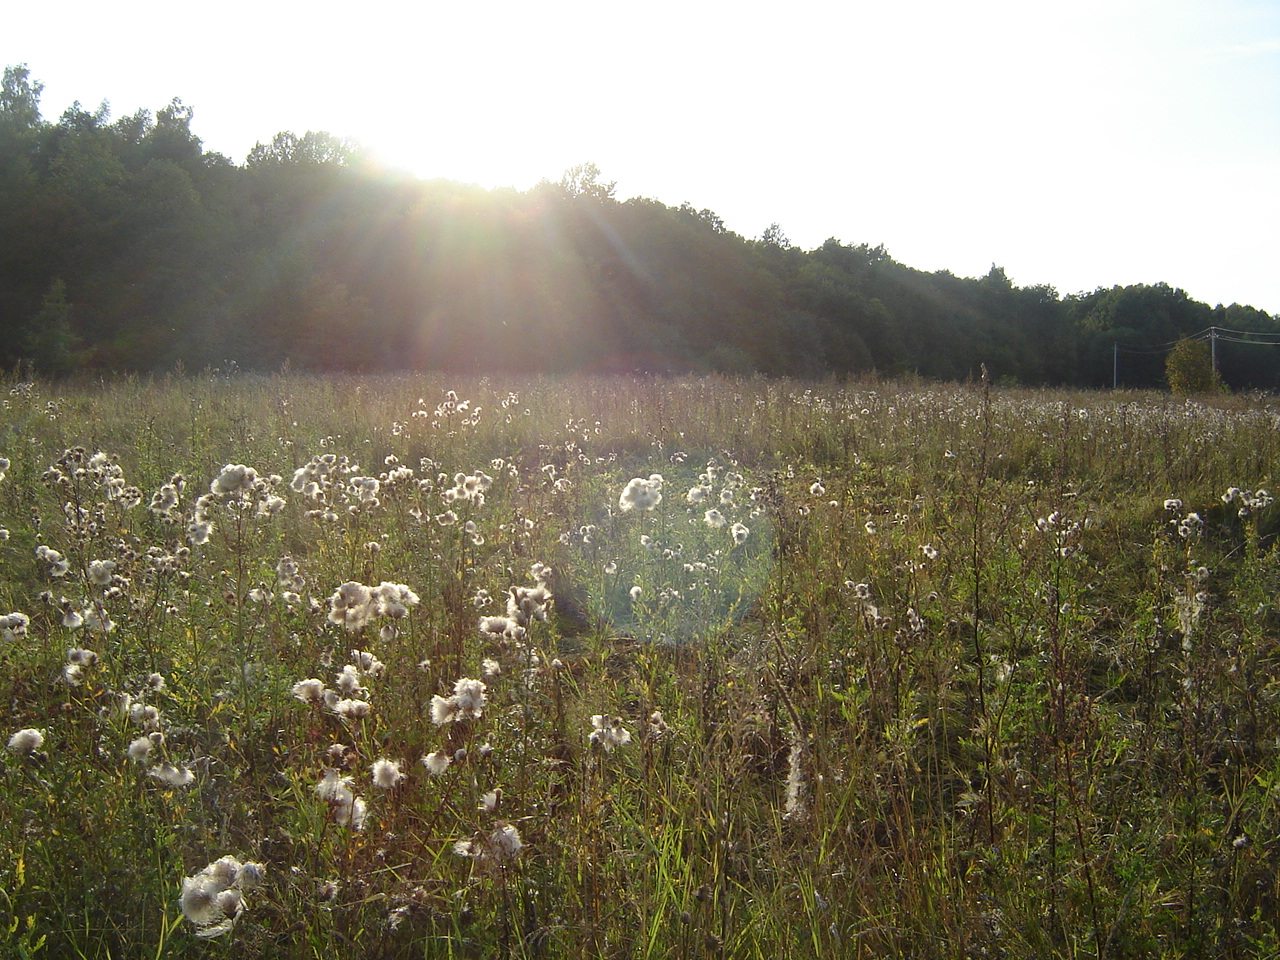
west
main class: Grassland
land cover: Spontaneously vegetated surfaces
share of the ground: > 75 %
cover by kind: herbaceous plants 100 %
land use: Fallow land
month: August
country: LT
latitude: 54.6025
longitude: 25.1495
